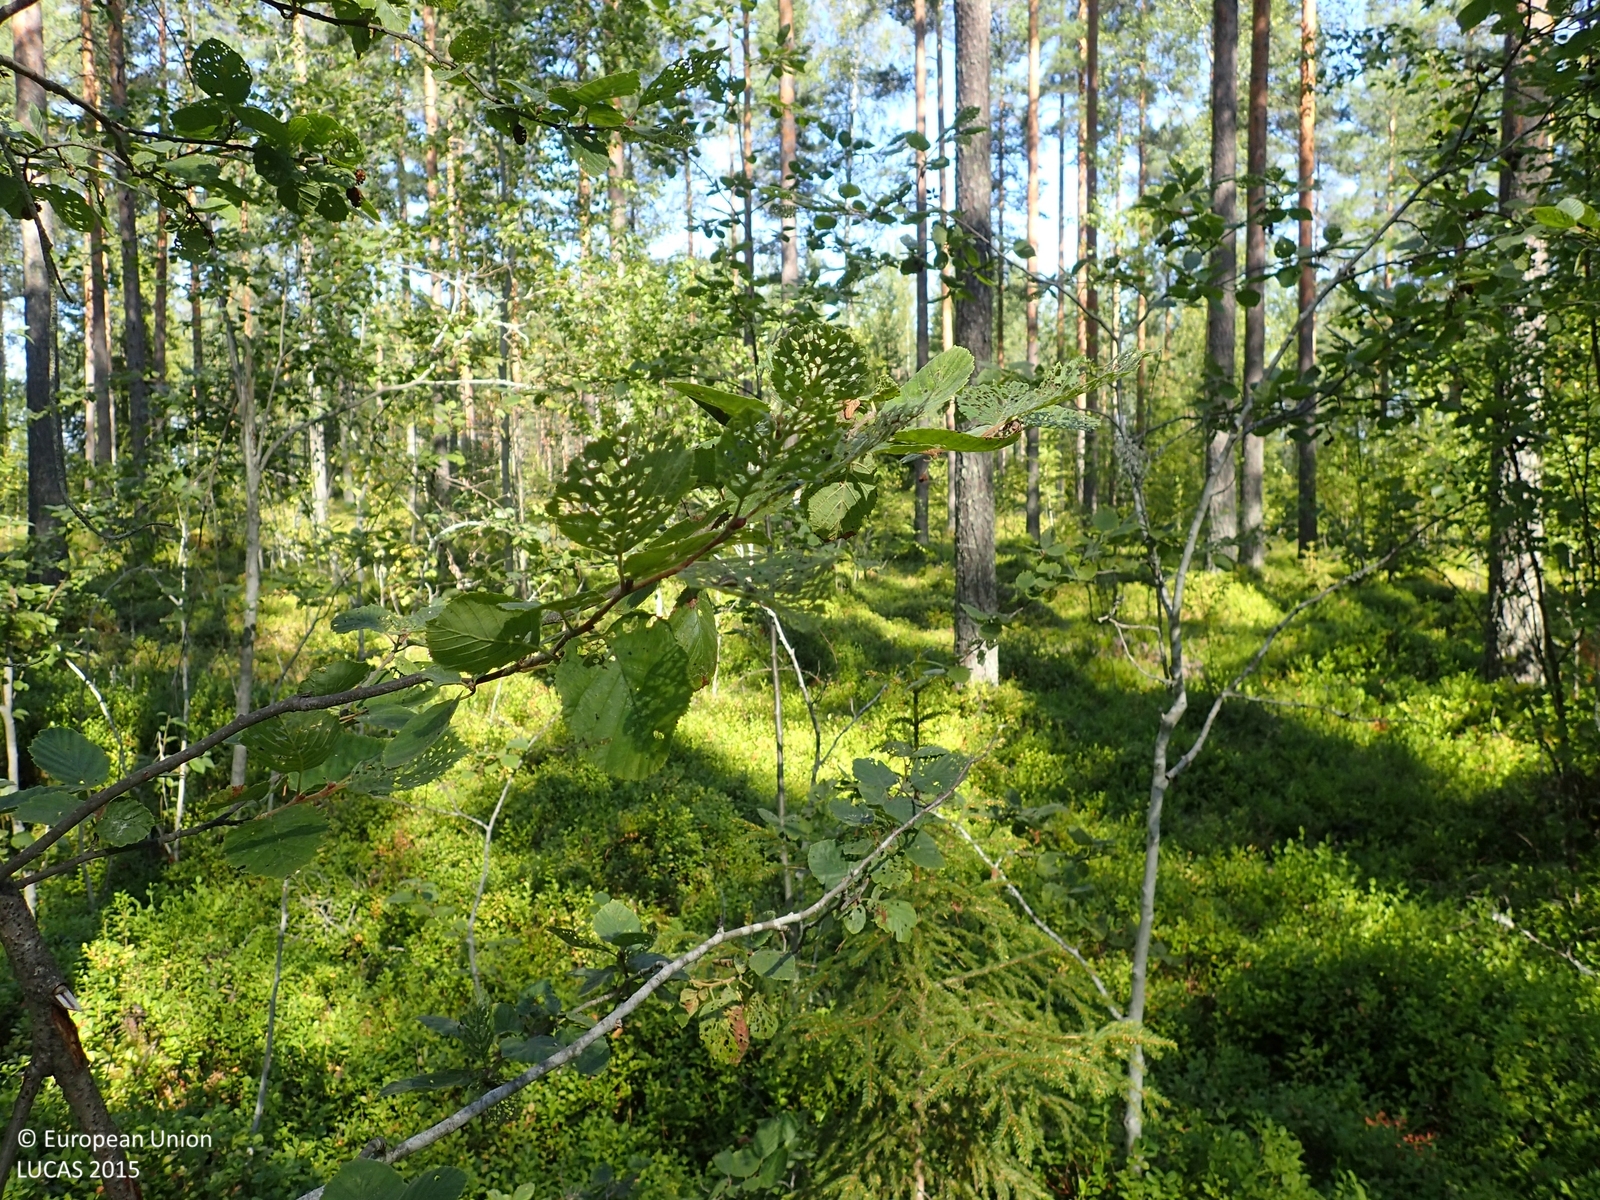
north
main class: Woodland
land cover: Pine dominated mixed woodland
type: boreal forest
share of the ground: 50 - 75 %
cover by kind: coniferous forest trees 45 %, shrubs 40 %, broadleaved forest trees 15 %
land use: Forestry
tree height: > 5 m
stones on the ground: < 10 %
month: August
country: FI
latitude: 62.3909
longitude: 21.9446
